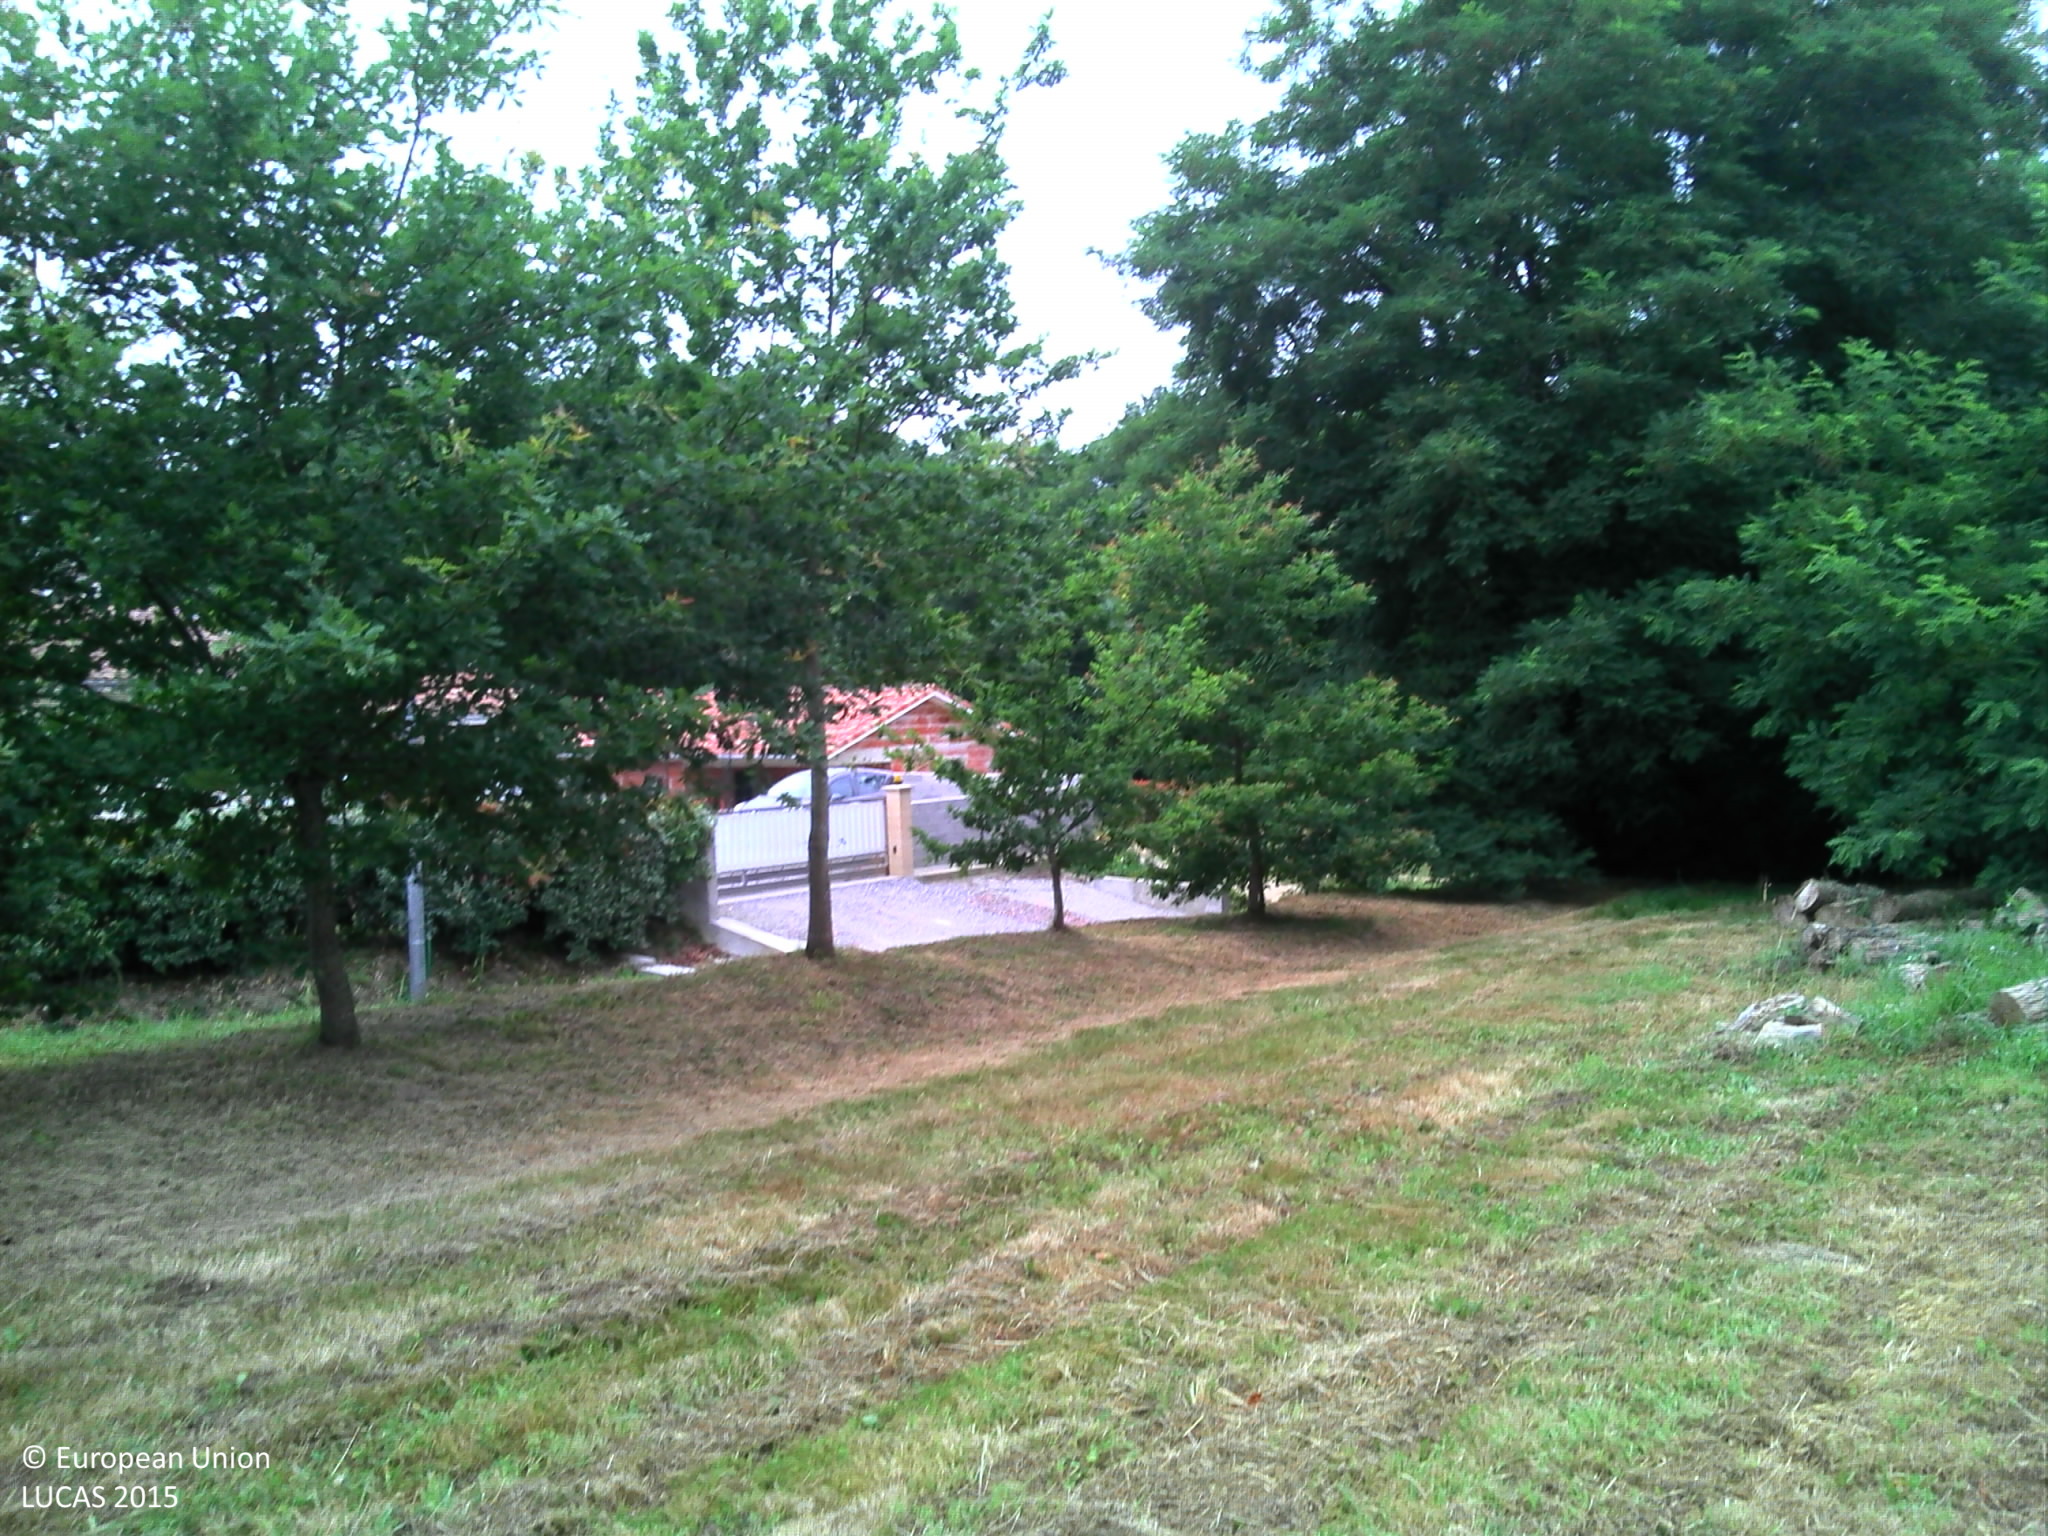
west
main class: Grassland
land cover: Grassland without tree/shrub cover
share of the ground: > 75 %
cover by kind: herbaceous plants 100 %
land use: Residential
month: July
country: FR
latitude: 43.5992
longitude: -1.1775
